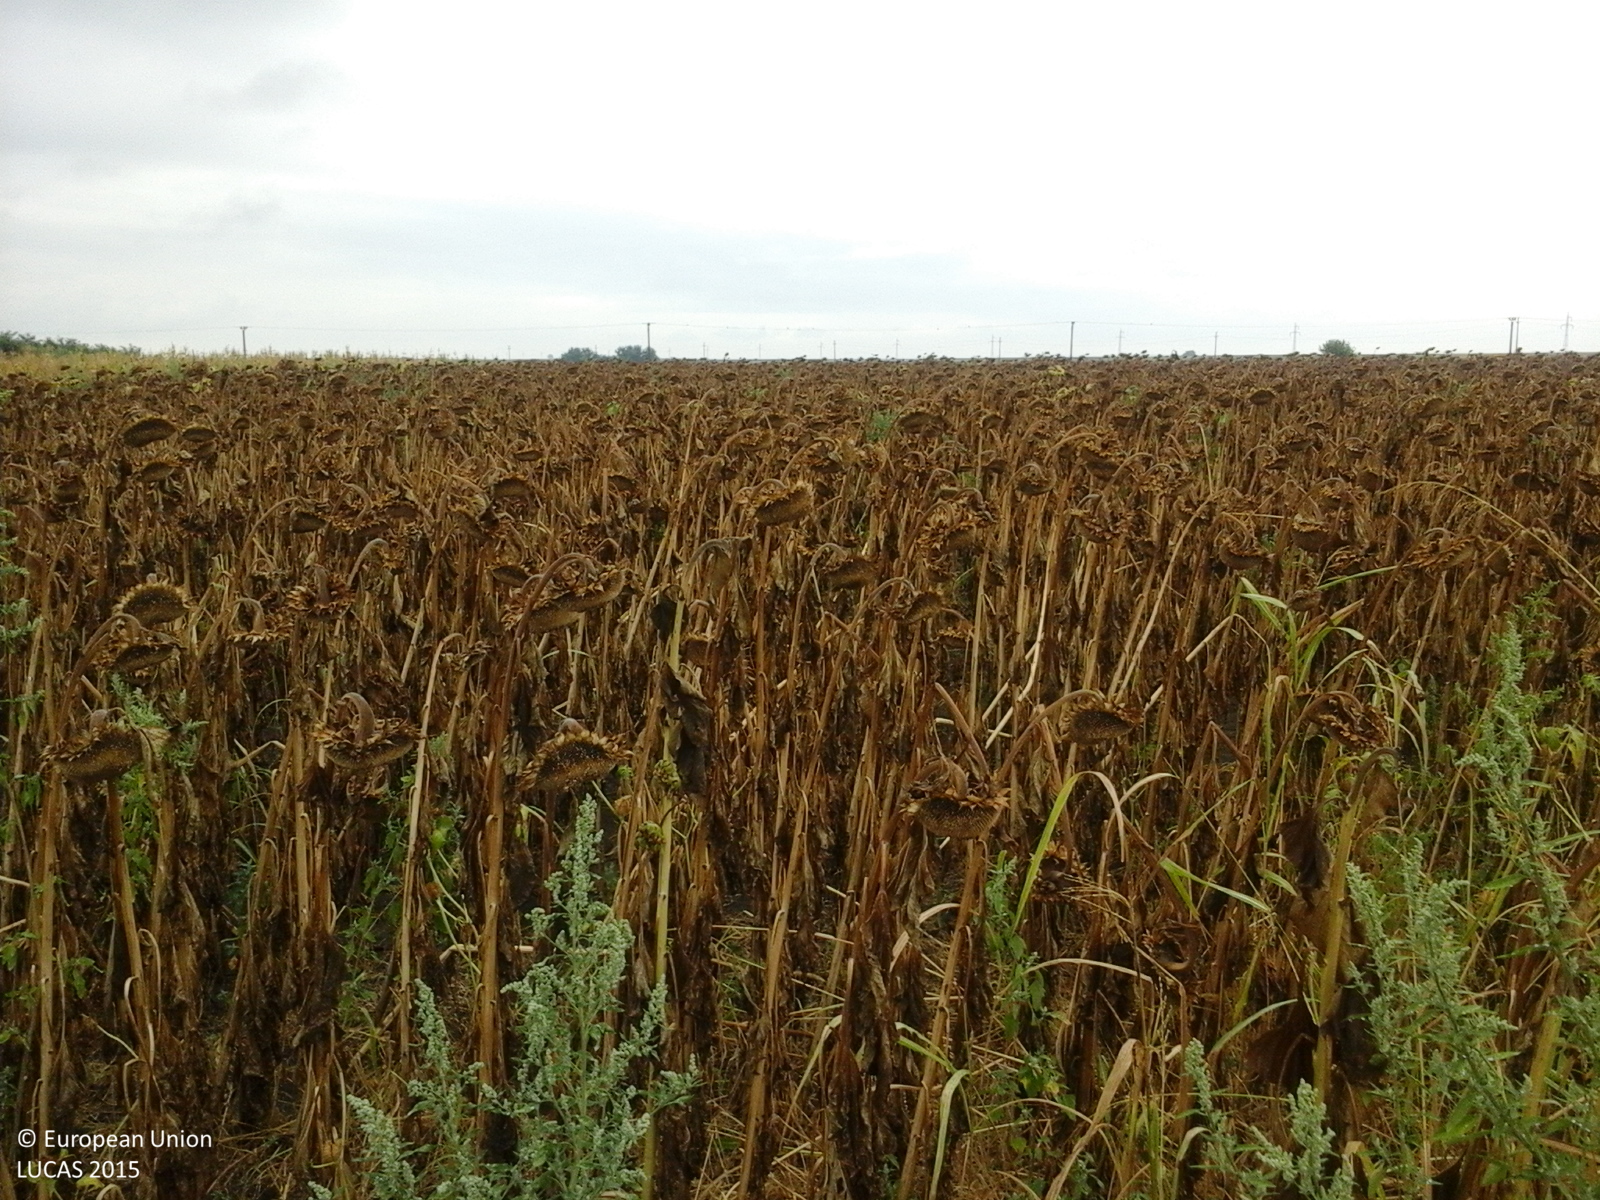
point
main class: Cropland
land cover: Sunflower
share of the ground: > 75 %
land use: Agriculture (excluding fallow land and kitchen gardens)
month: August
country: RO
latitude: 45.9738
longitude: 20.7256
